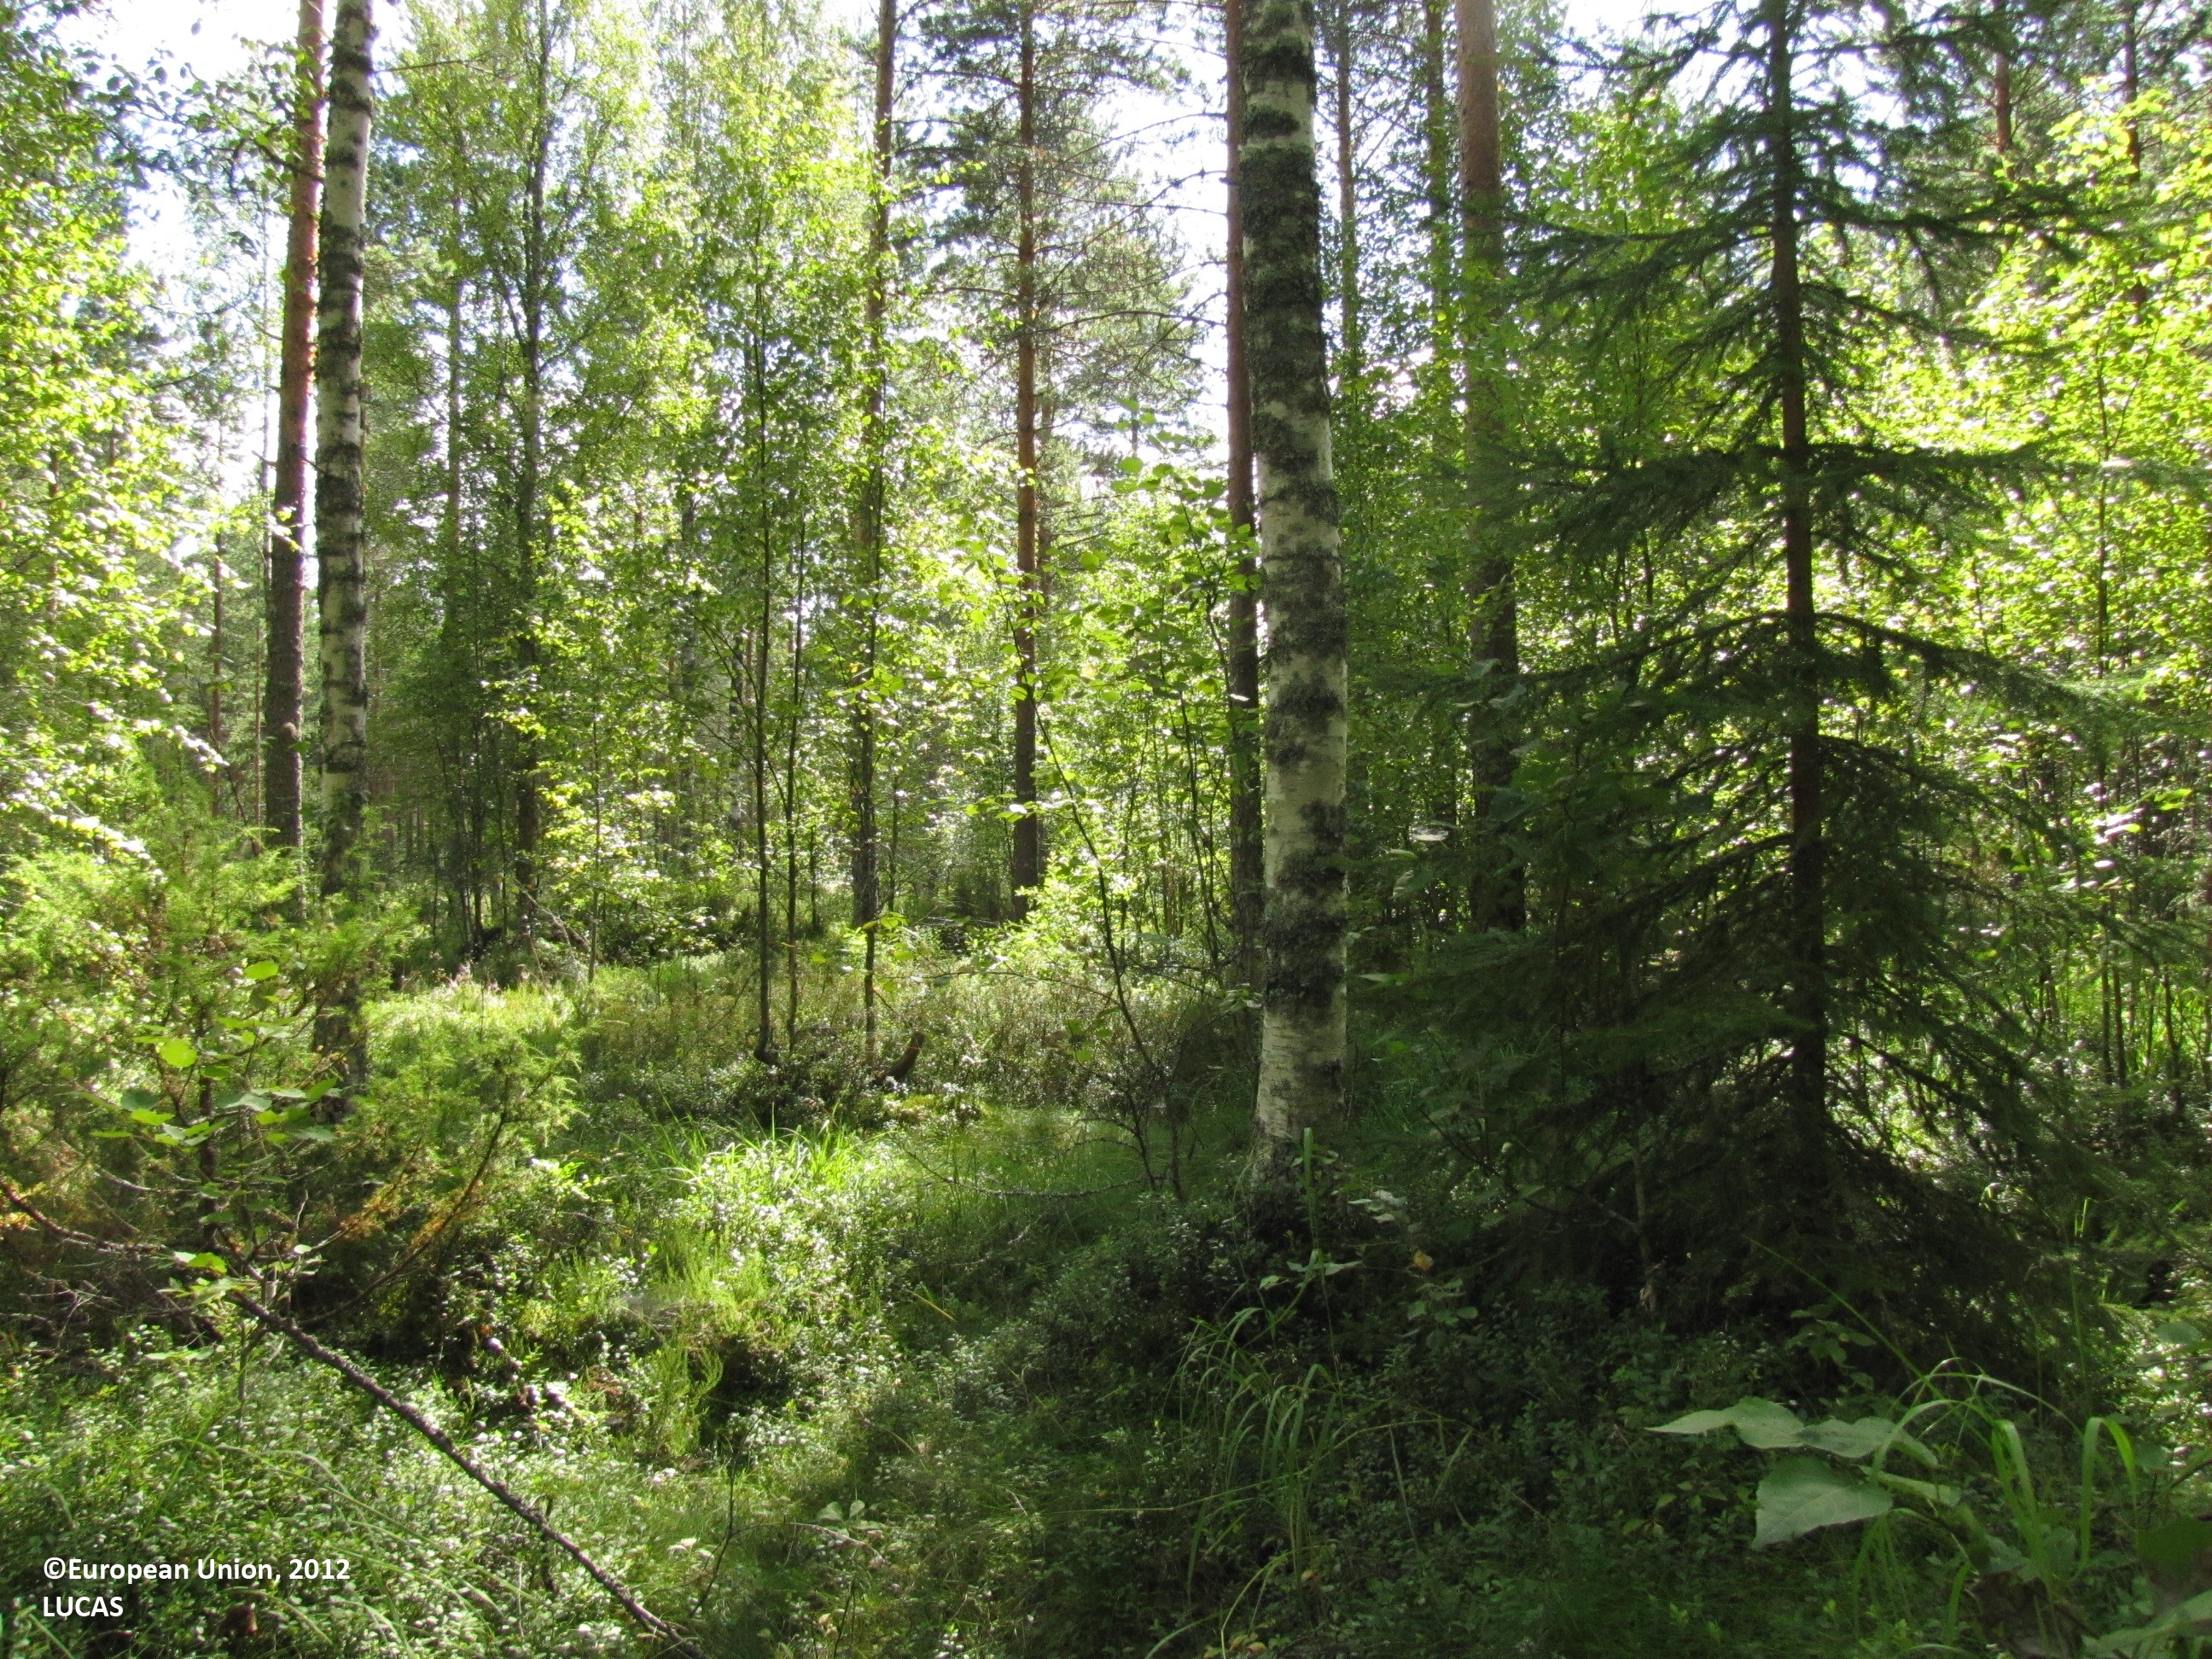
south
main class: Woodland
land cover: Pine dominated mixed woodland
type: boreal forest
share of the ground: > 75 %
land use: Forestry
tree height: > 5 m
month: August
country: FI
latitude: 61.7268
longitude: 22.8794
